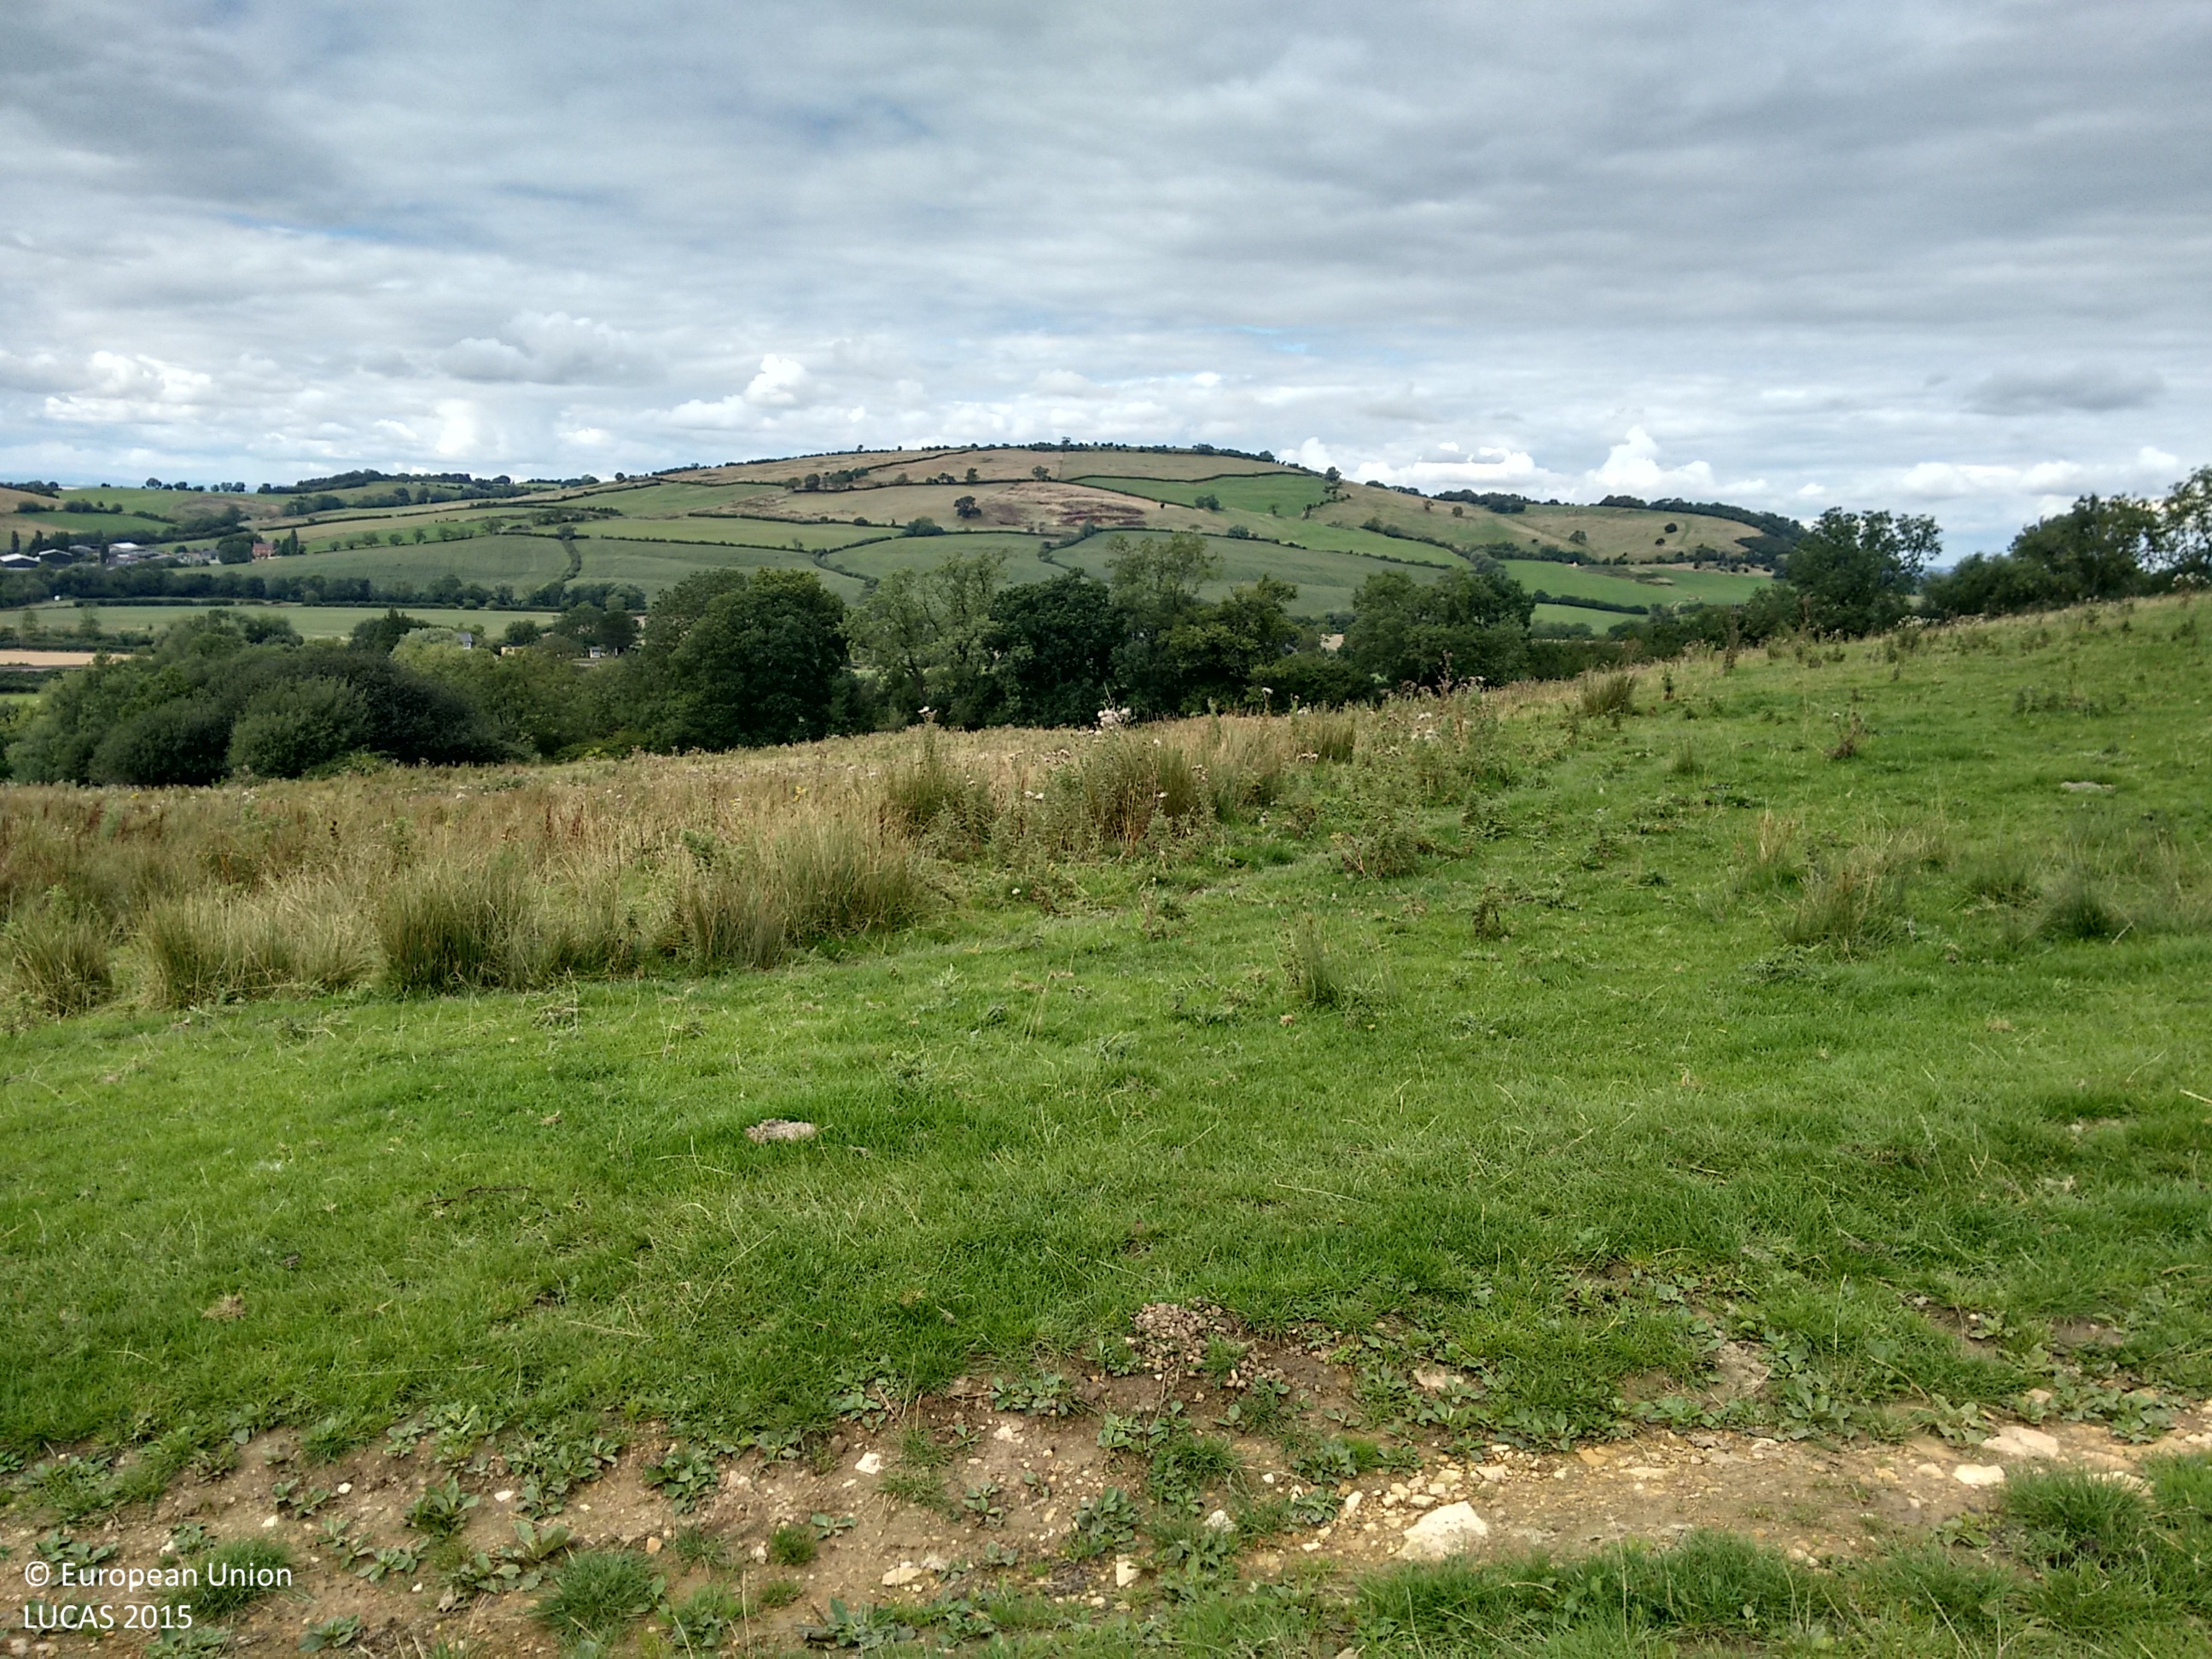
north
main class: Grassland
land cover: Grassland without tree/shrub cover
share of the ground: > 75 %
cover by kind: herbaceous plants 100 %
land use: Agriculture (excluding fallow land and kitchen gardens)
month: September
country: GB
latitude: 51.9623
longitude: -2.0366
